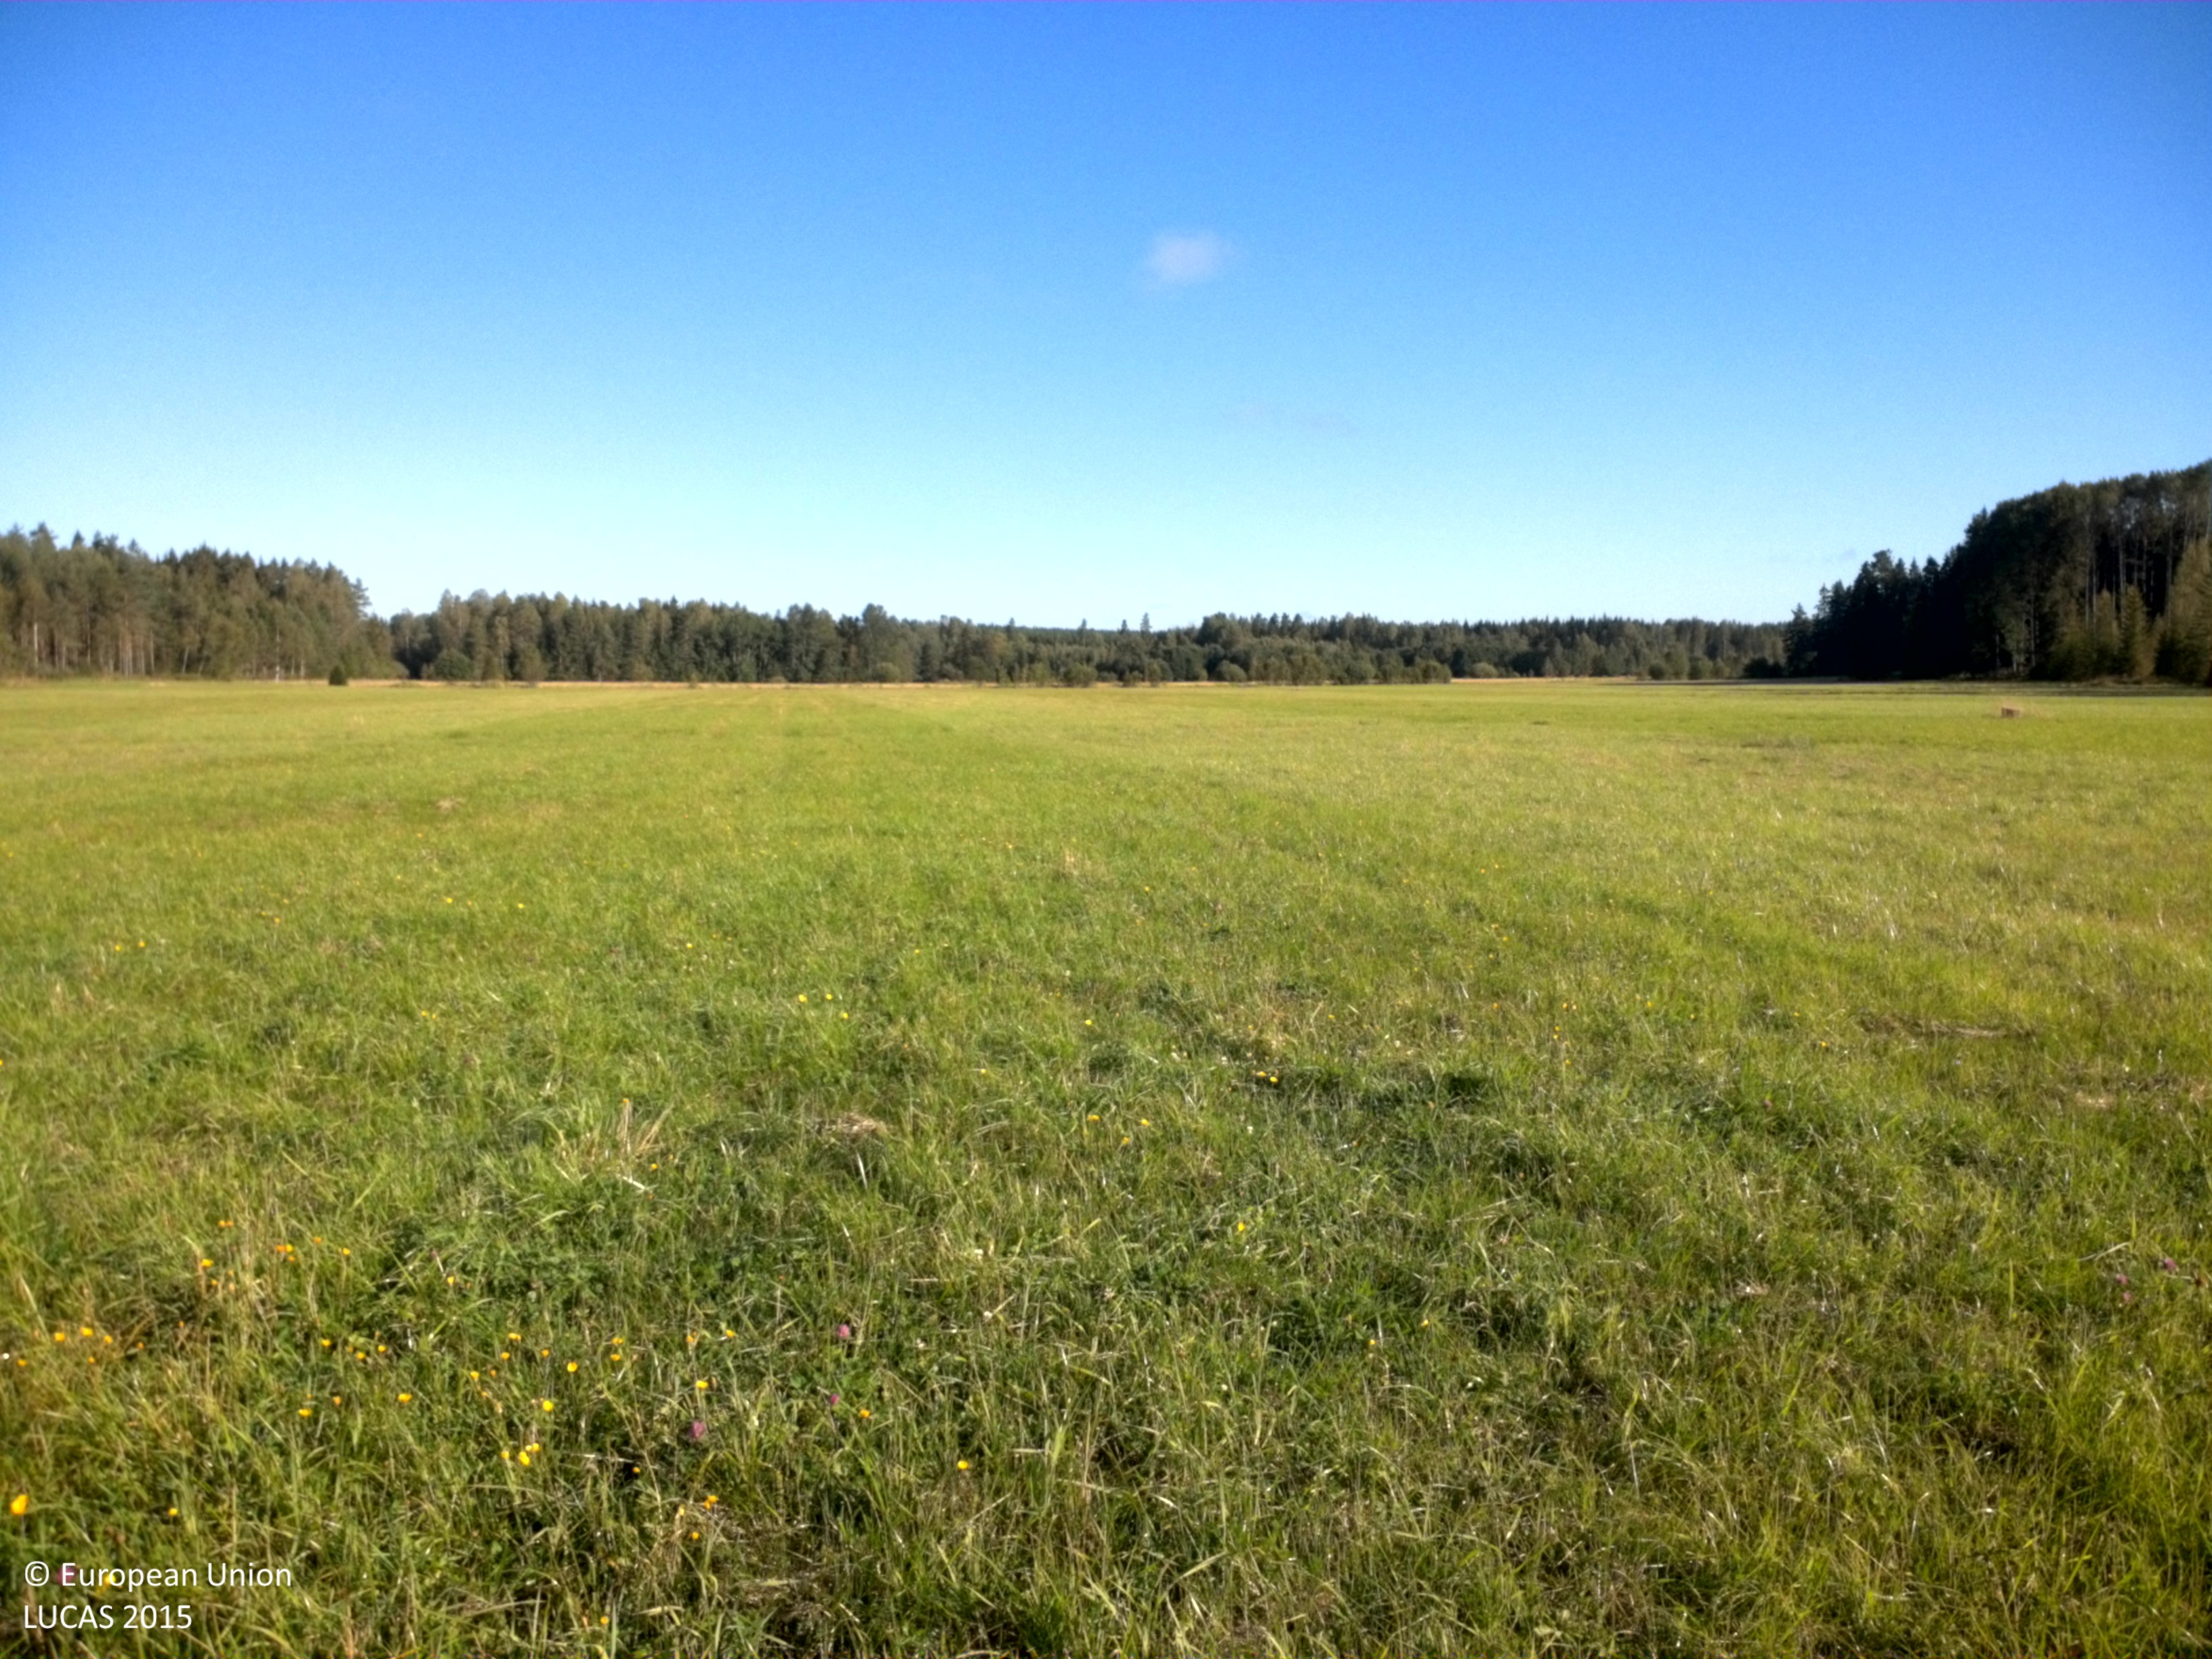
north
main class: Grassland
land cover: Grassland without tree/shrub cover
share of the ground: > 75 %
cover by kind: herbaceous plants 90 %, consolidated bare surface 10 %
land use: Agriculture (excluding fallow land and kitchen gardens)
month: August
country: SE
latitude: 59.4714
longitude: 13.4689
